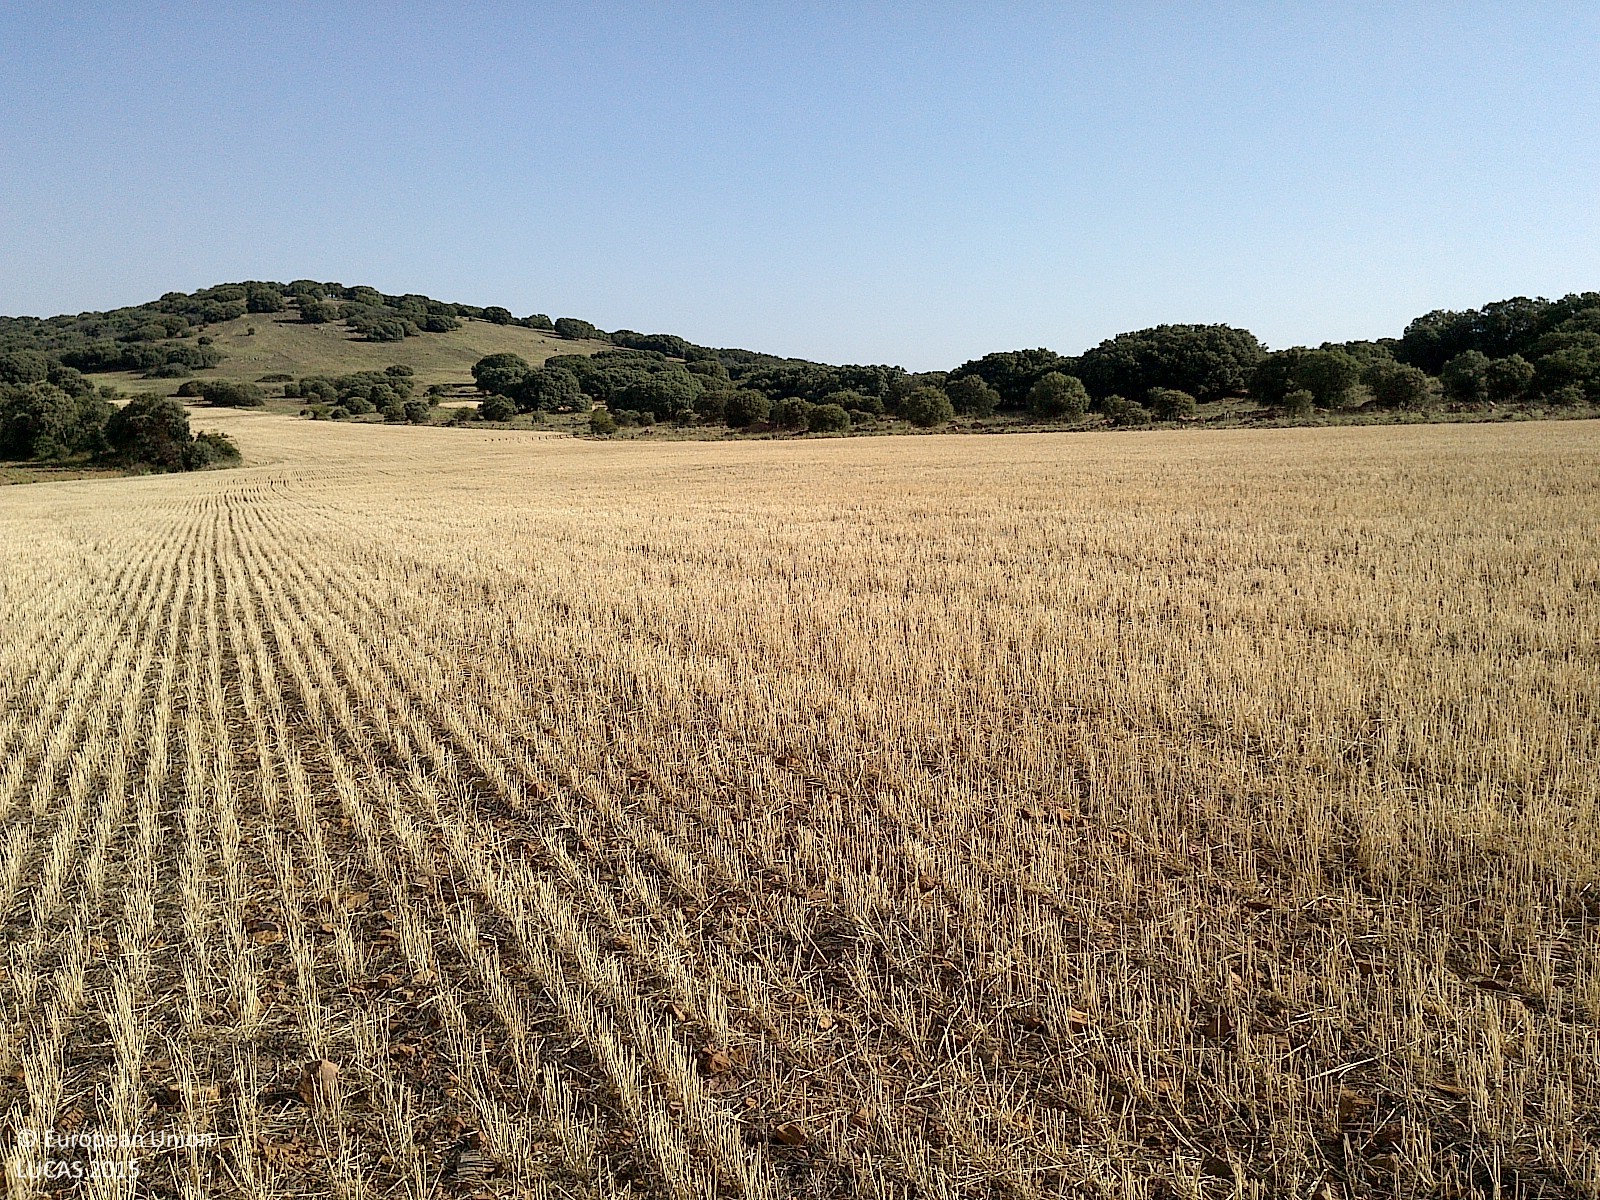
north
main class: Cropland
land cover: Barley
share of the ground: < 10 %
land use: Agriculture (excluding fallow land and kitchen gardens)
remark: Harvested field
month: July
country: ES
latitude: 41.4675
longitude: -1.9671
